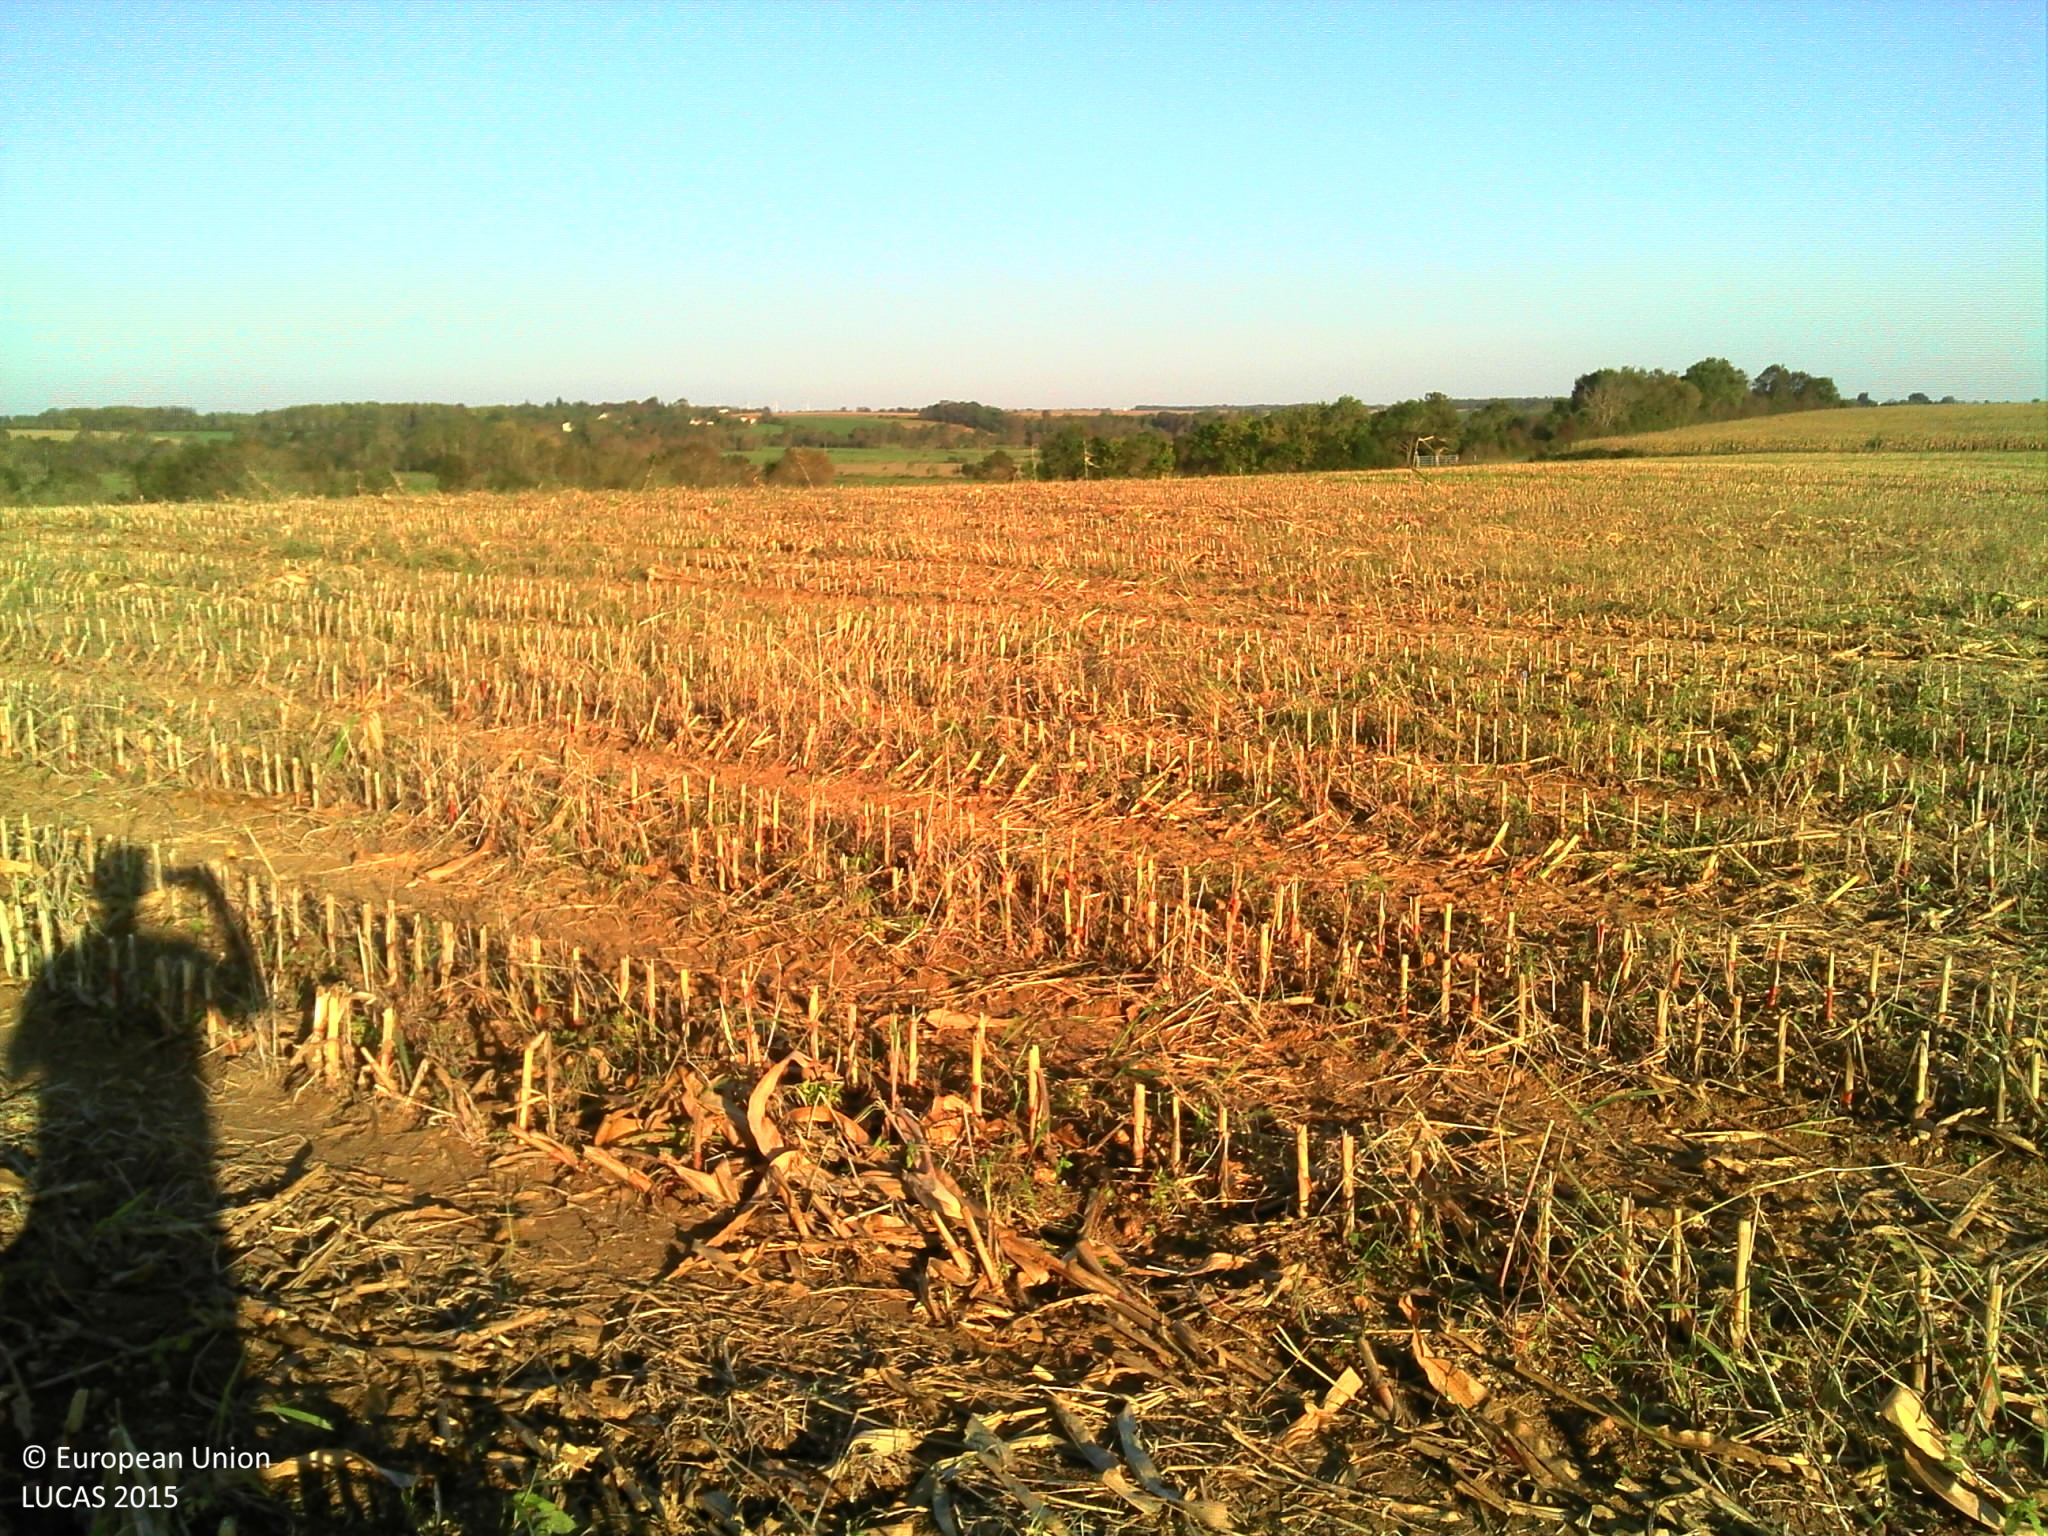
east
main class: Cropland
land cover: Maize
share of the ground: 10 - 25 %
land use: Agriculture (excluding fallow land and kitchen gardens)
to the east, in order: Maize
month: September
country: FR
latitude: 46.4978
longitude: -1.2798
